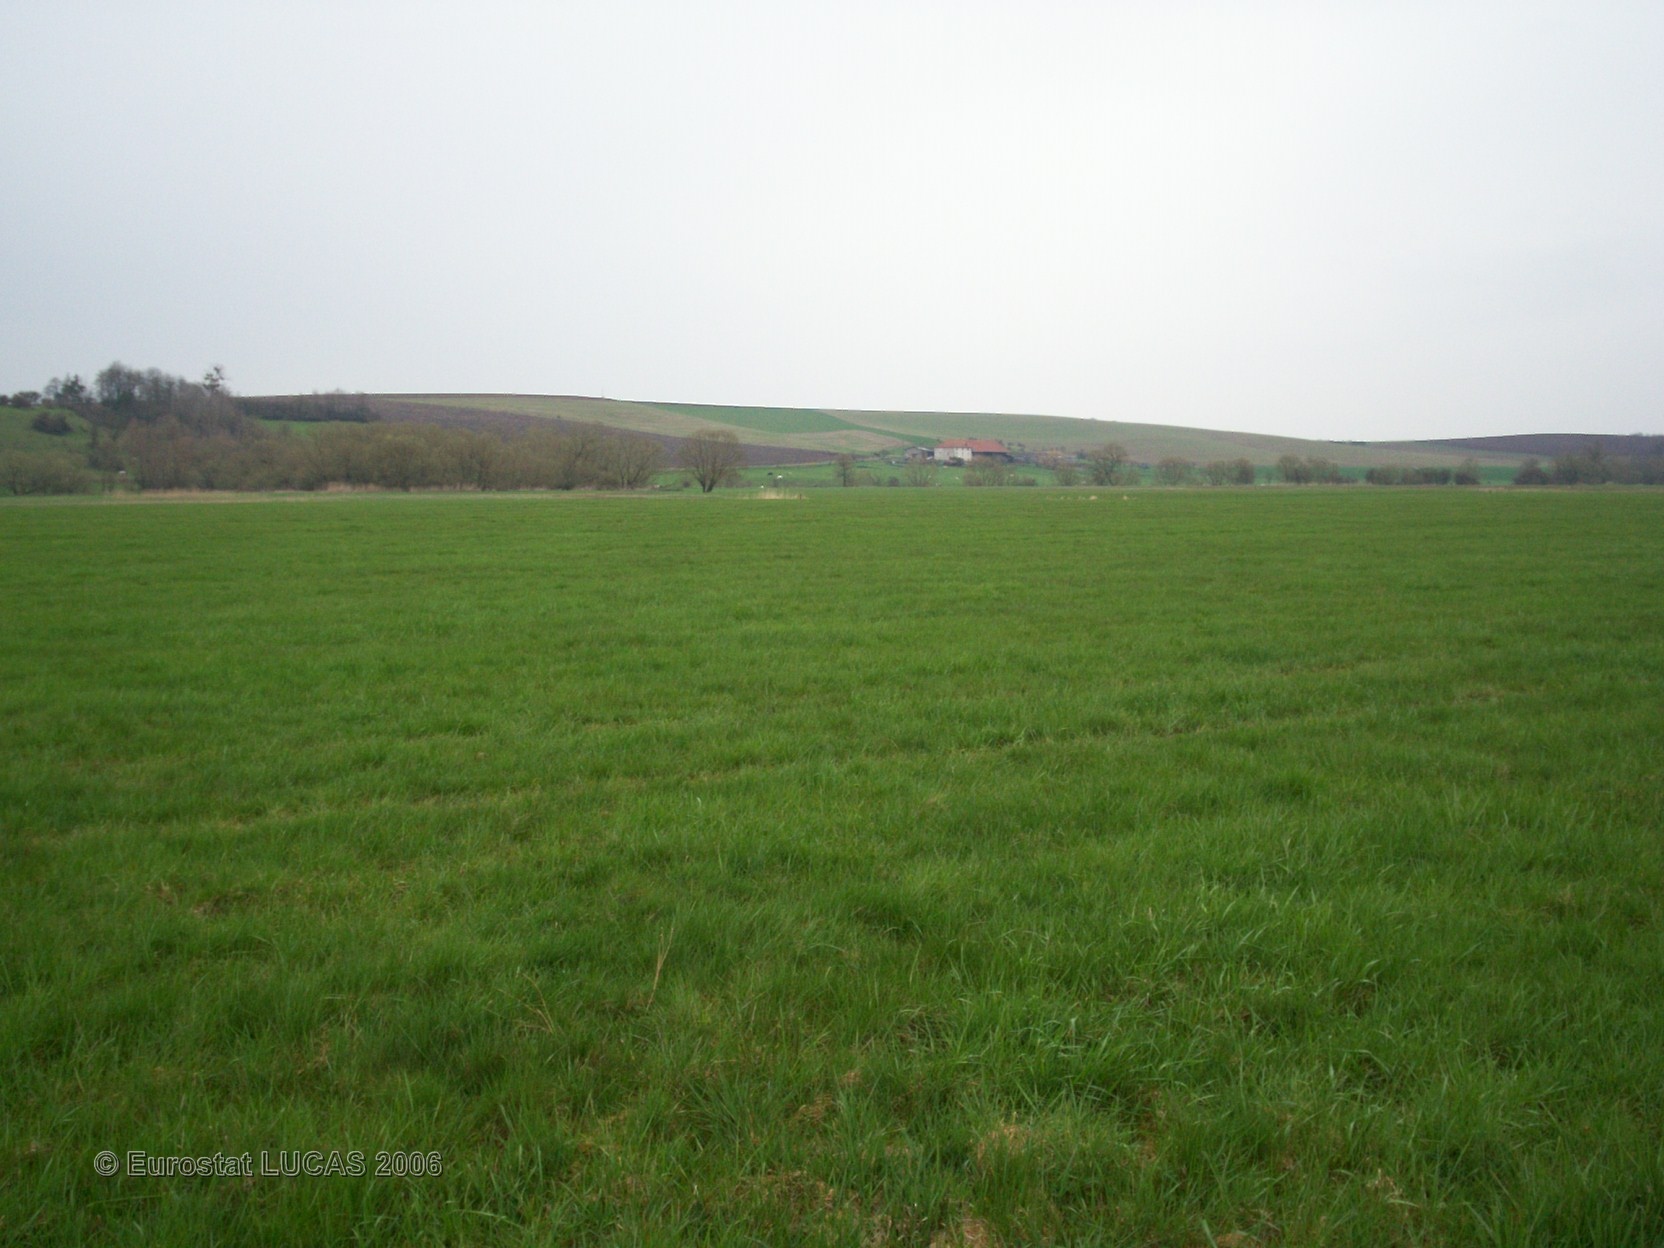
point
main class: Grassland
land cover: Grassland without tree/shrub cover
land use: Agriculture (excluding fallow land and kitchen gardens)
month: April
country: FR
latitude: 48.6016
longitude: 6.5424
